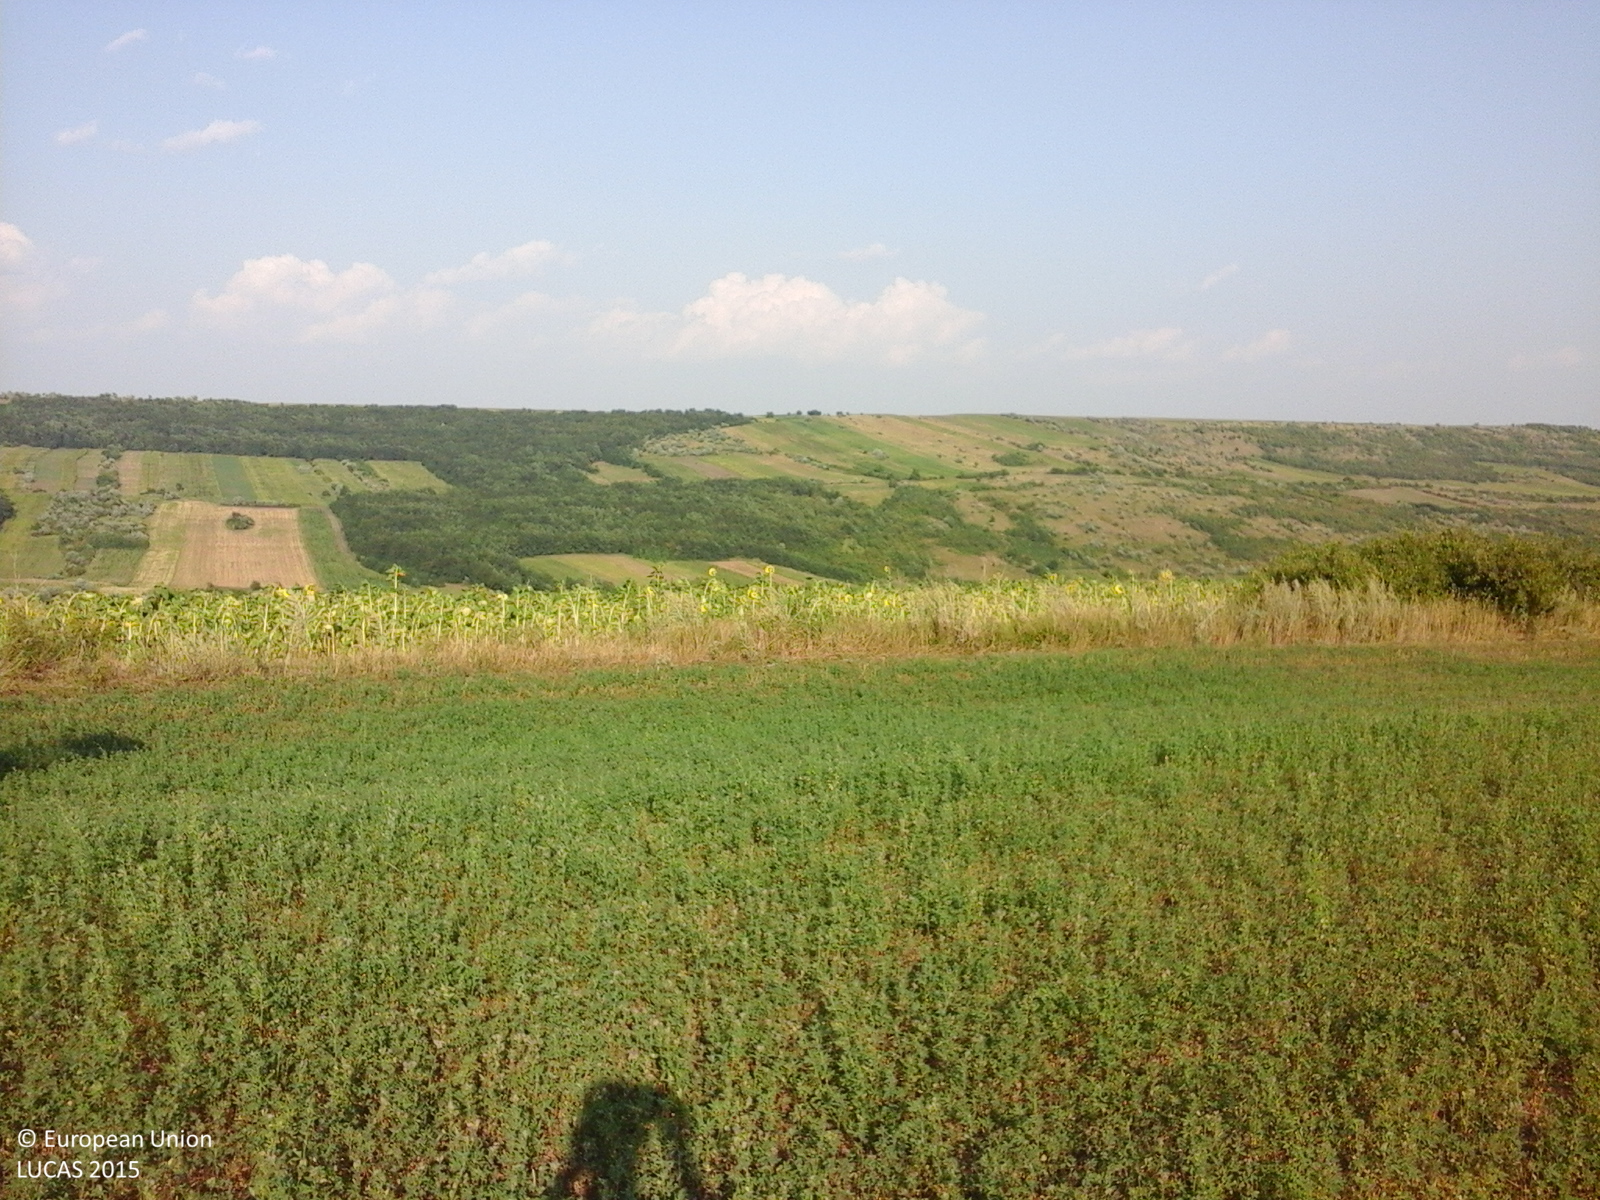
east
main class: Cropland
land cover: Lucerne
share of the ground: > 75 %
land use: Agriculture (excluding fallow land and kitchen gardens)
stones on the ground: < 10 %
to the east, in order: Lucerne; Grass margins; Sunflower; Maize; Sunflower; Maize; Sunflower; Maize; Lines of trees; Maize; Lines of trees; Tracks; Common wheat; Sunflower; Maize; Lines of trees; Maize; Lines of trees
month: July
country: RO
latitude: 46.3086
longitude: 27.6296
